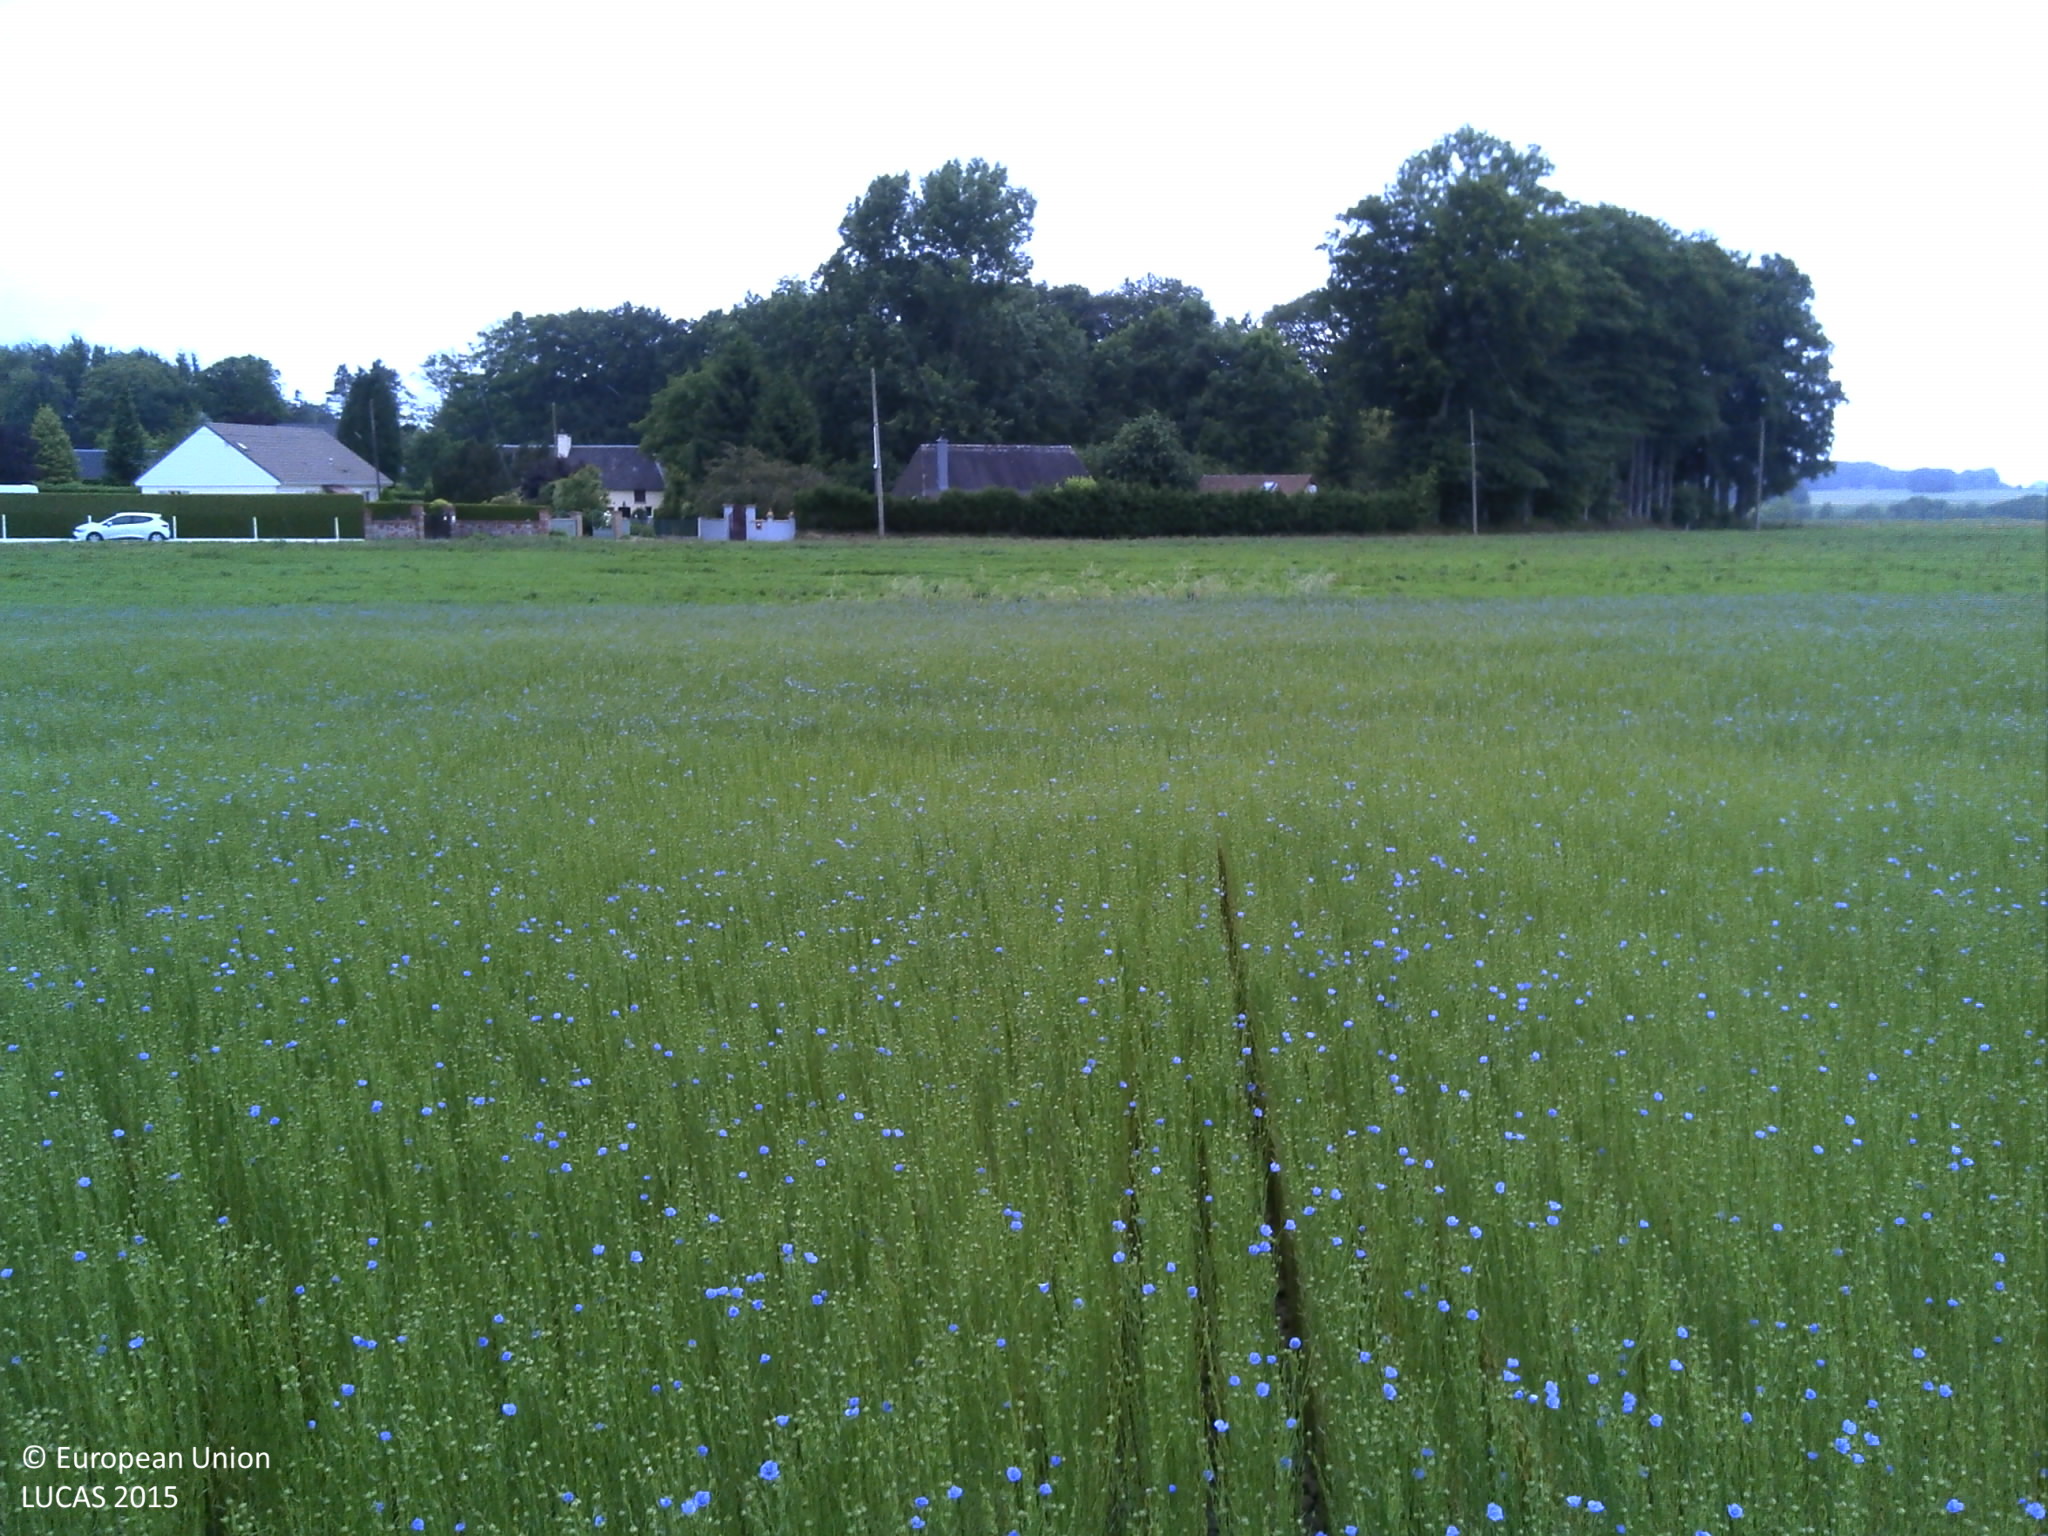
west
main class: Cropland
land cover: Other fibre and oleaginous crops
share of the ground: > 75 %
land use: Agriculture (excluding fallow land and kitchen gardens)
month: June
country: FR
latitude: 49.7035
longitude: 0.5868
